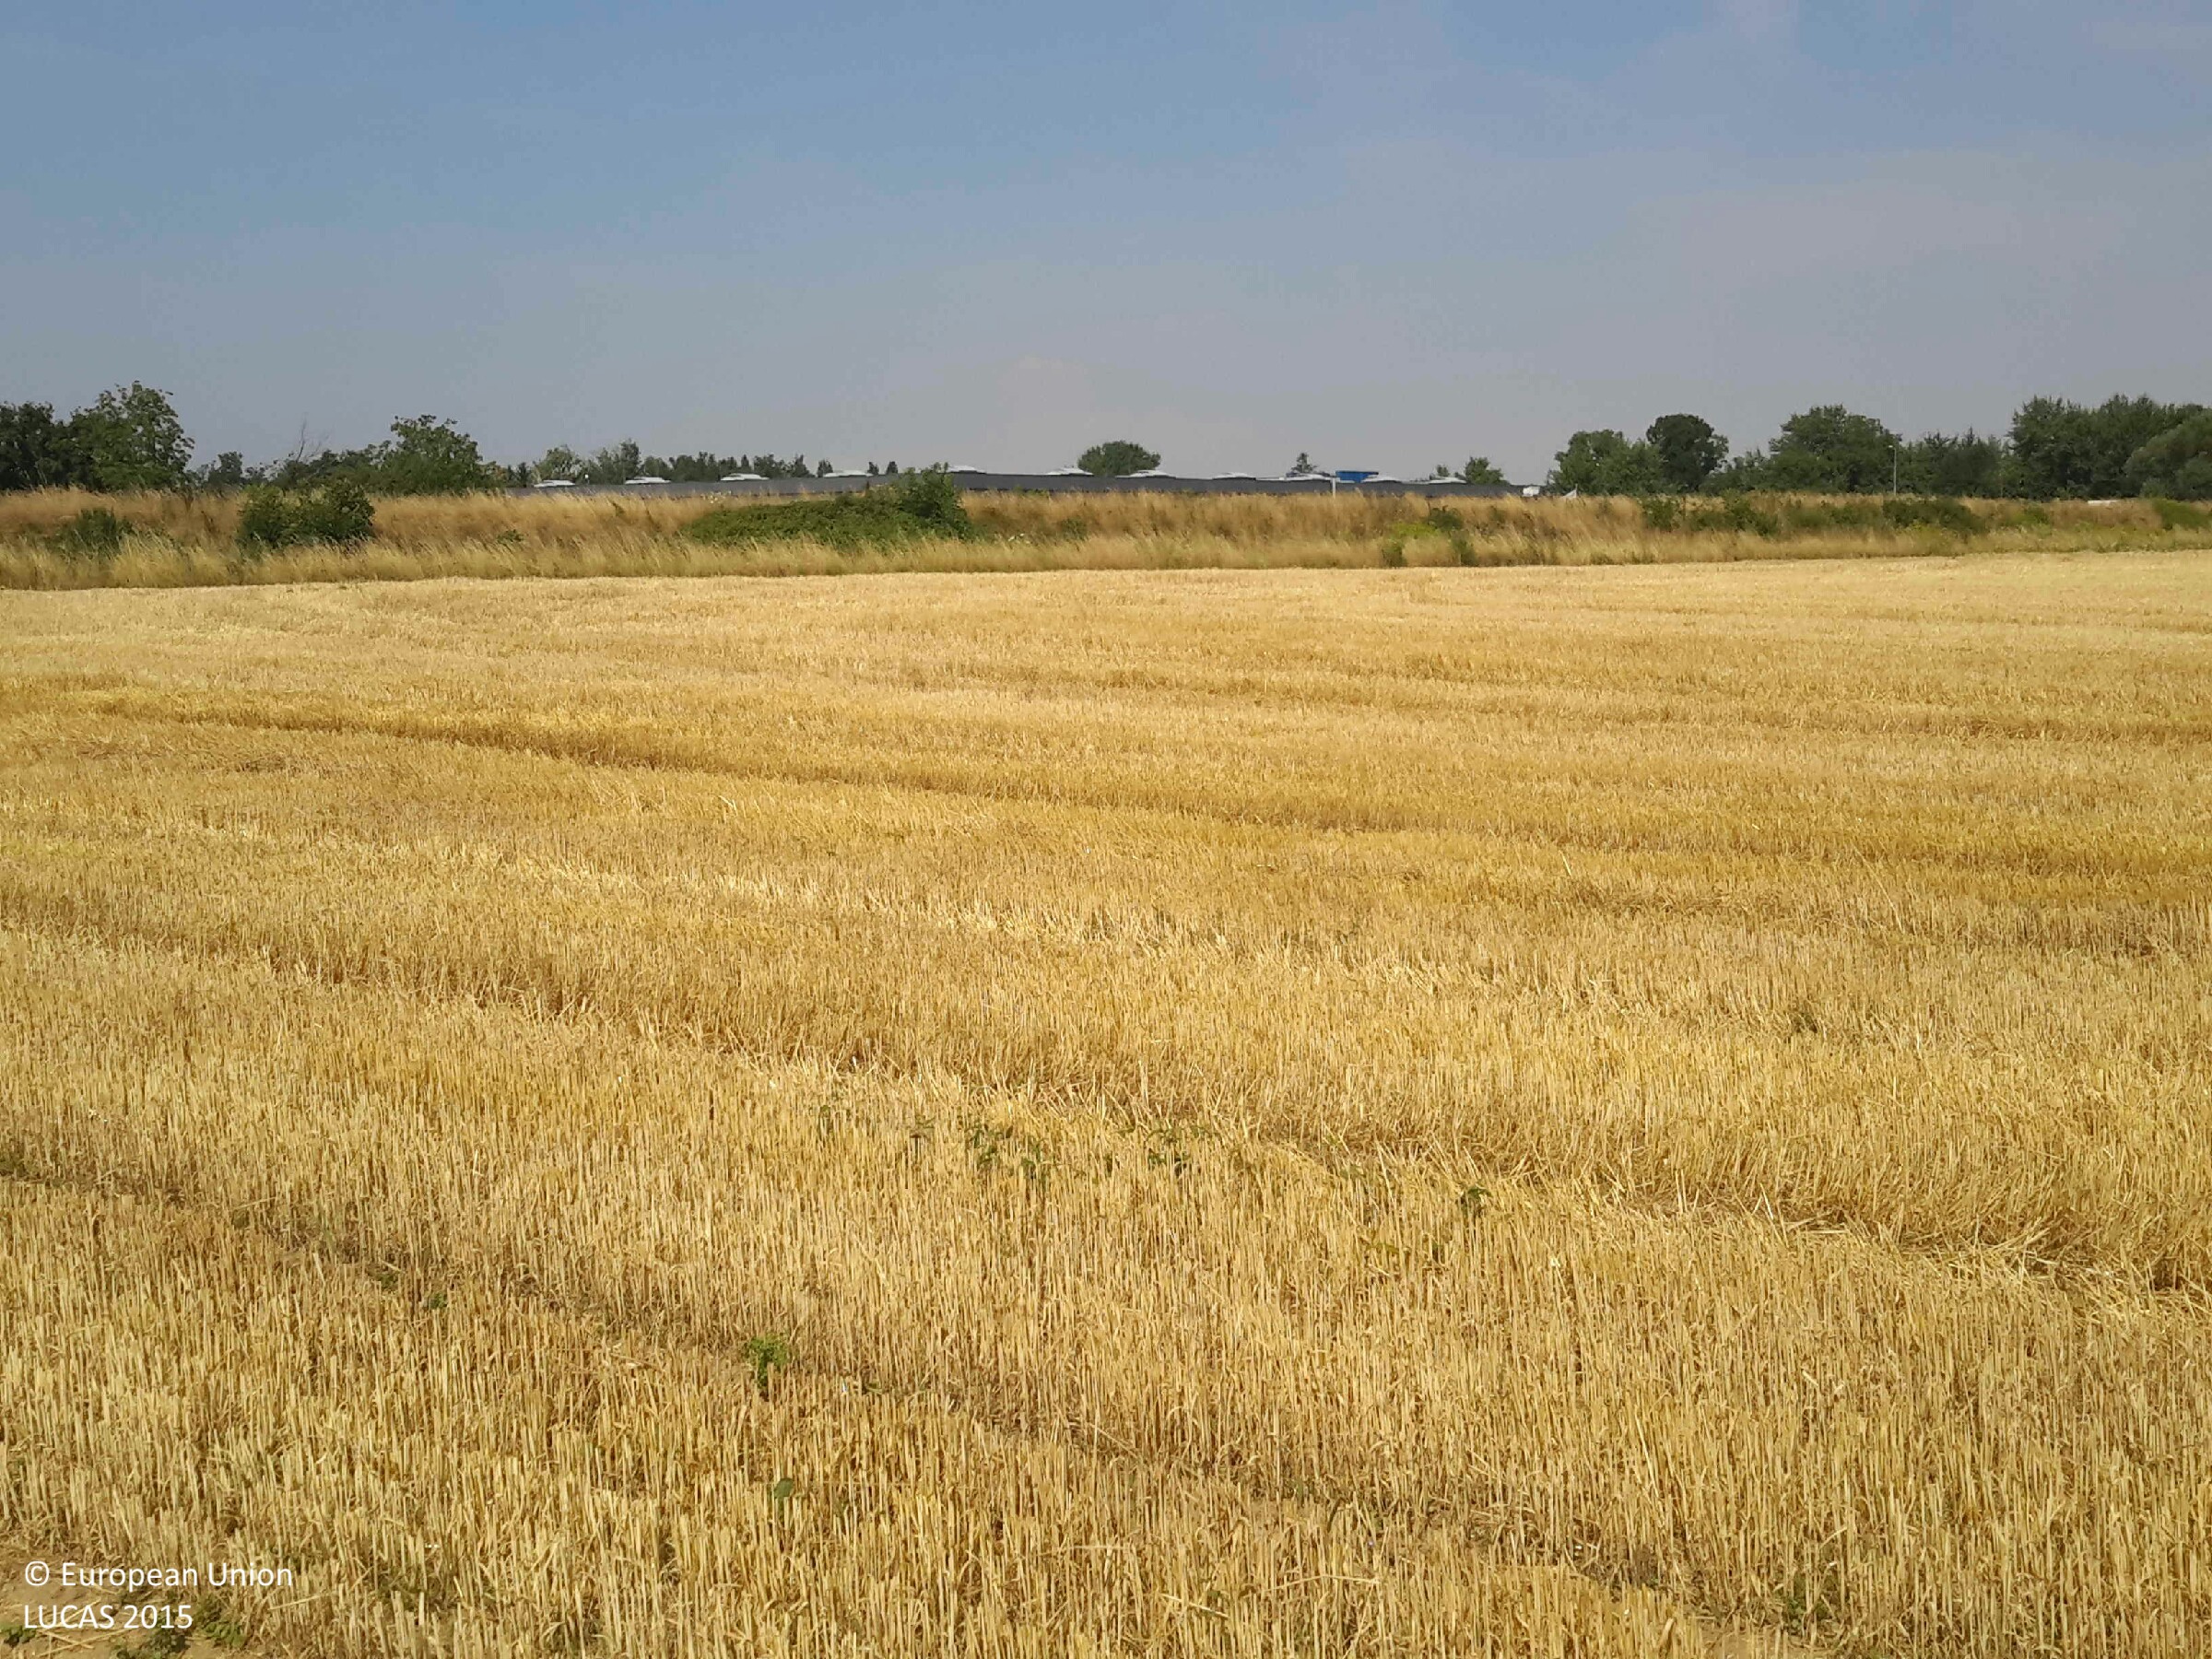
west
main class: Cropland
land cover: Common wheat
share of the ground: 50 - 75 %
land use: Agriculture (excluding fallow land and kitchen gardens)
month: July
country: HU
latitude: 47.4043
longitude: 16.7227
